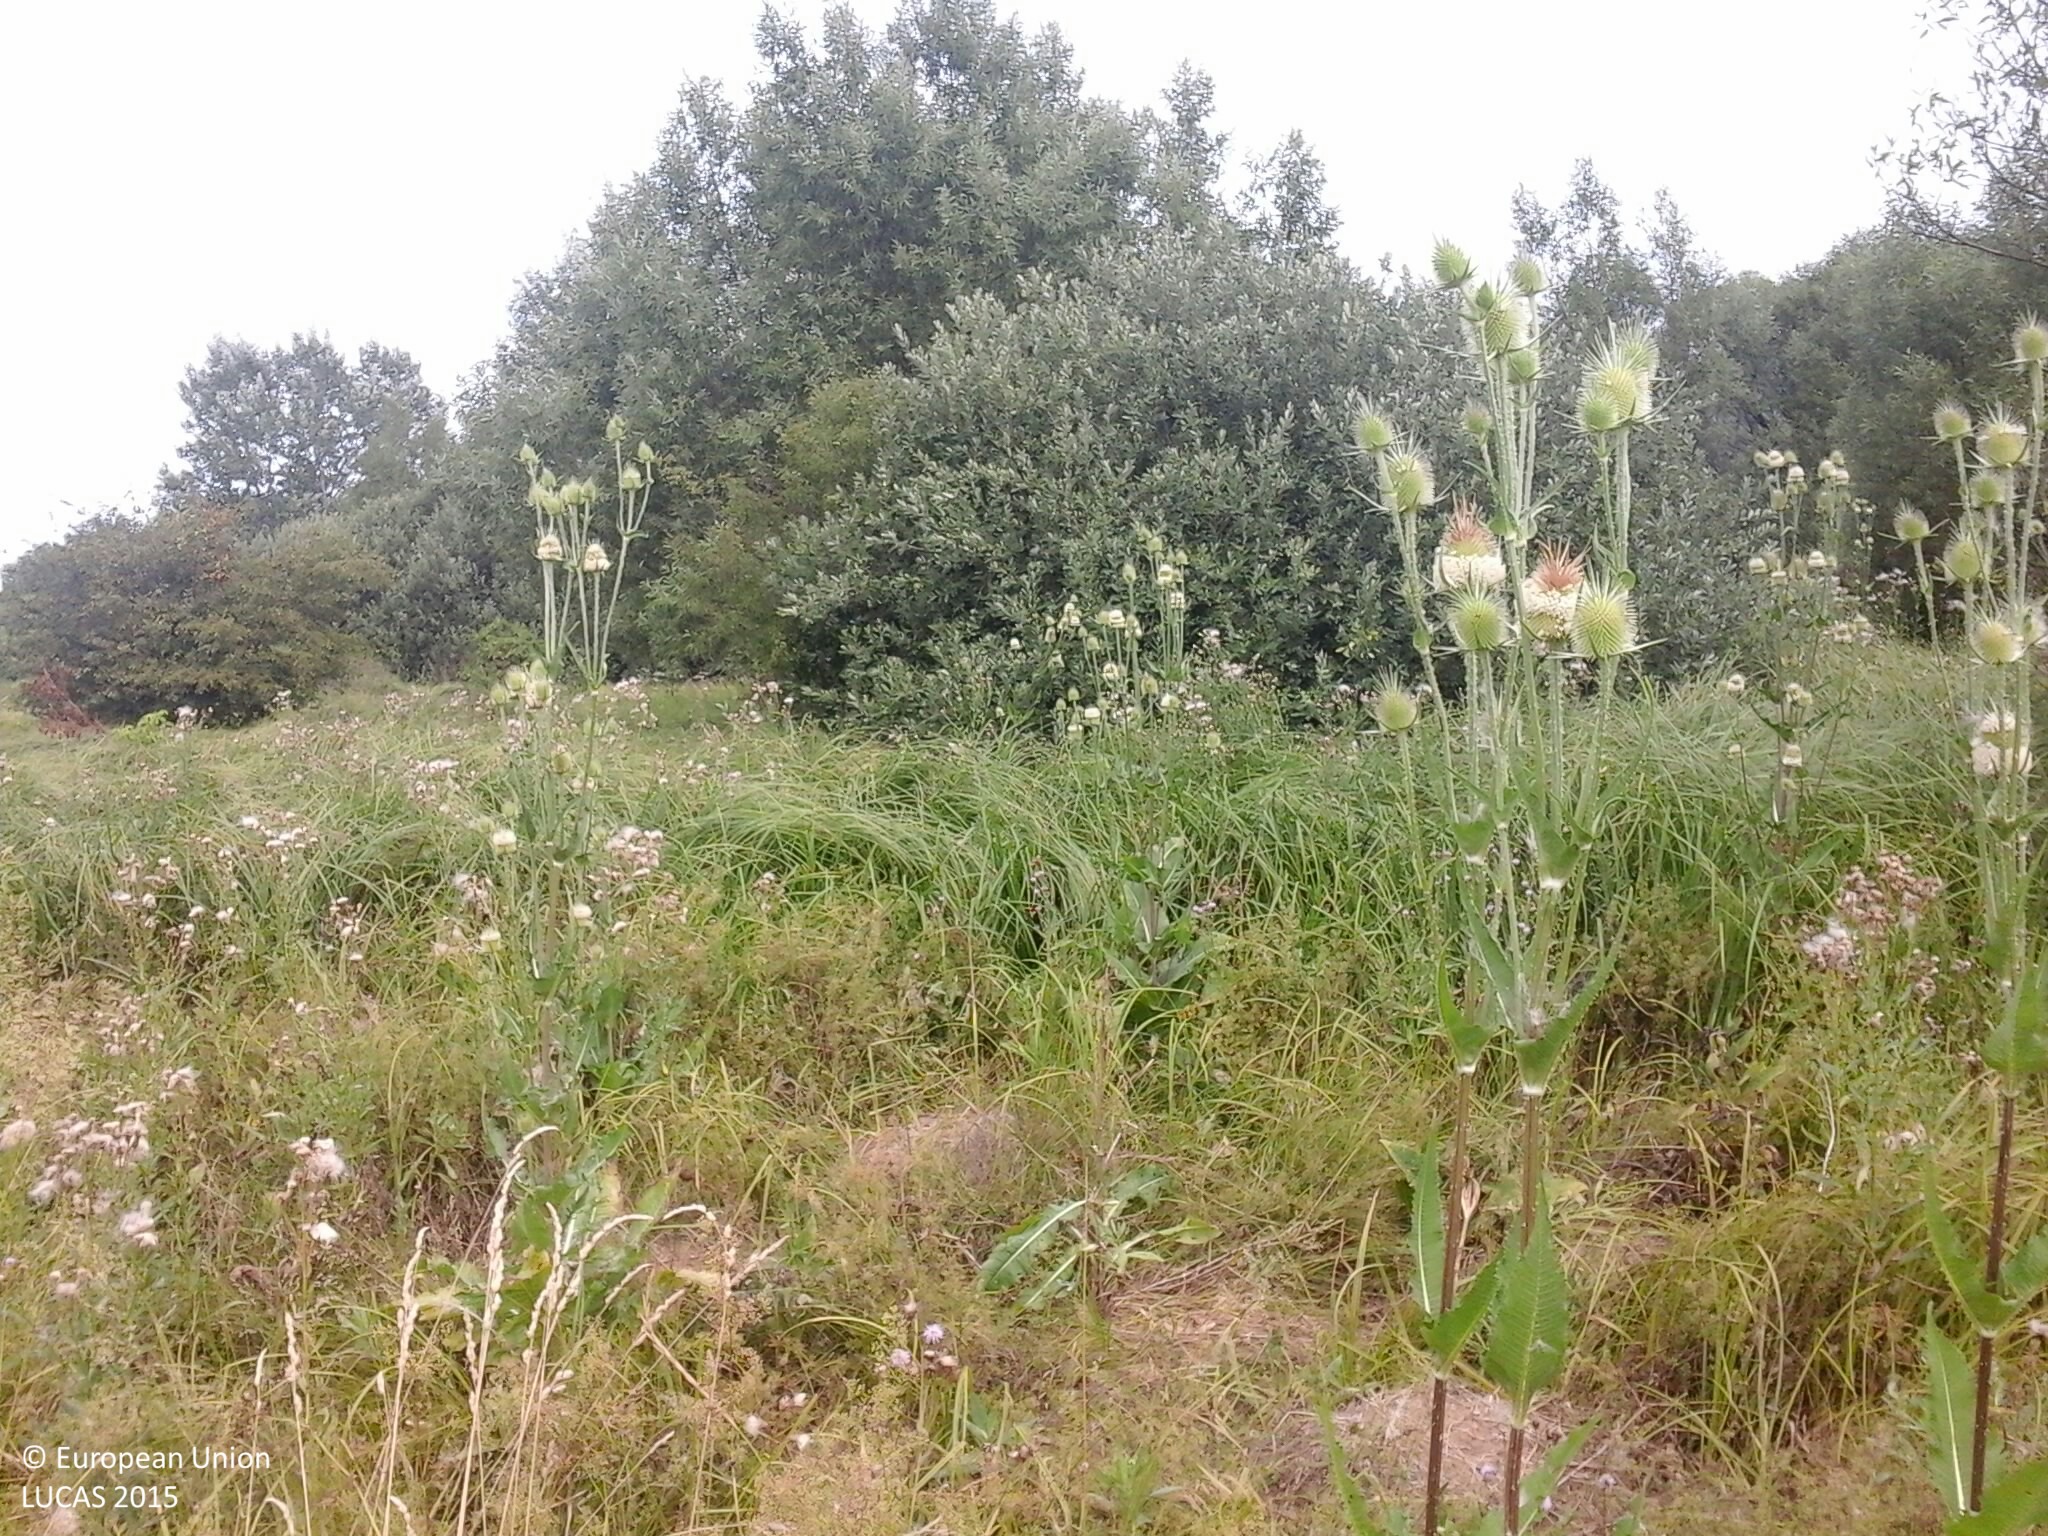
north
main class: Grassland
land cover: Grassland with sparse tree/shrub cover
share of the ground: > 75 %
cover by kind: herbaceous plants 95 %, broadleaved forest trees 5 %
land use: Semi-natural and natural areas not in use
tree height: < 5 m
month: July
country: HU
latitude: 47.9229
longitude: 19.2685
